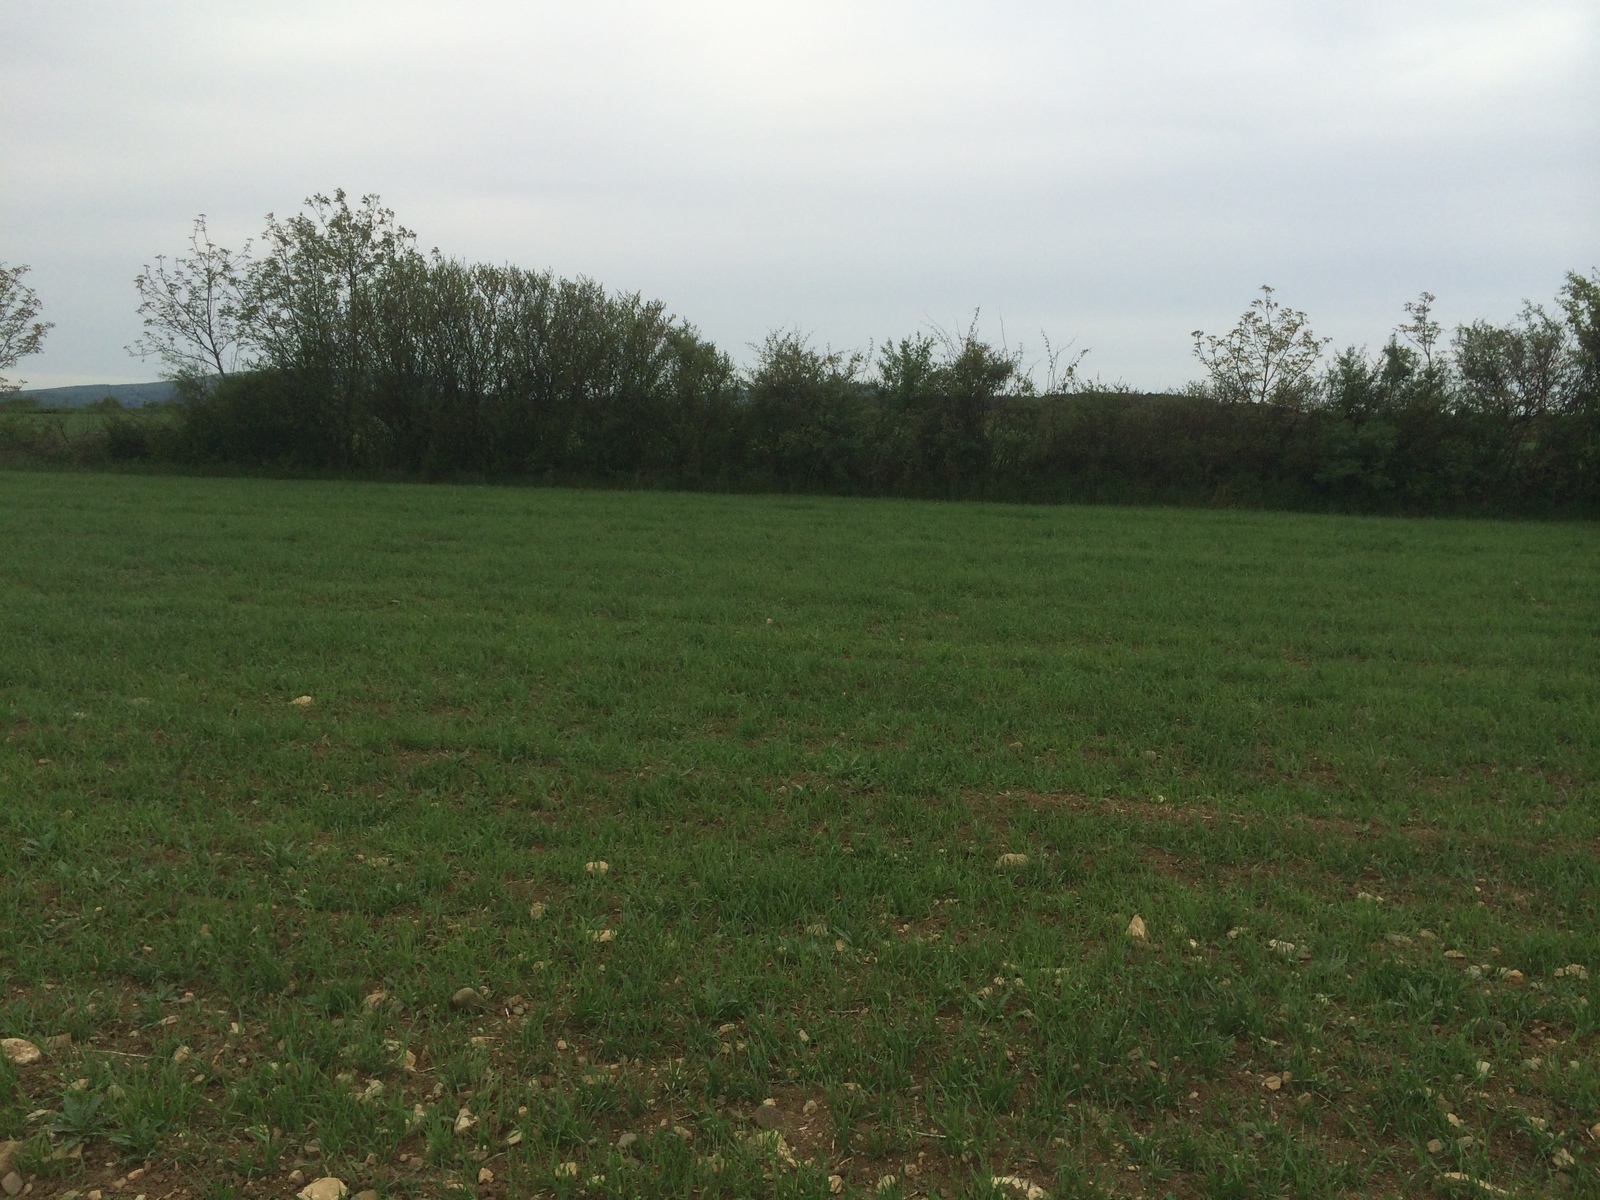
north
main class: Cropland
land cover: Barley
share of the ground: > 75 %
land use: Agriculture (excluding fallow land and kitchen gardens)
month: May
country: AT
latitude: 47.9436
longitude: 16.1488
